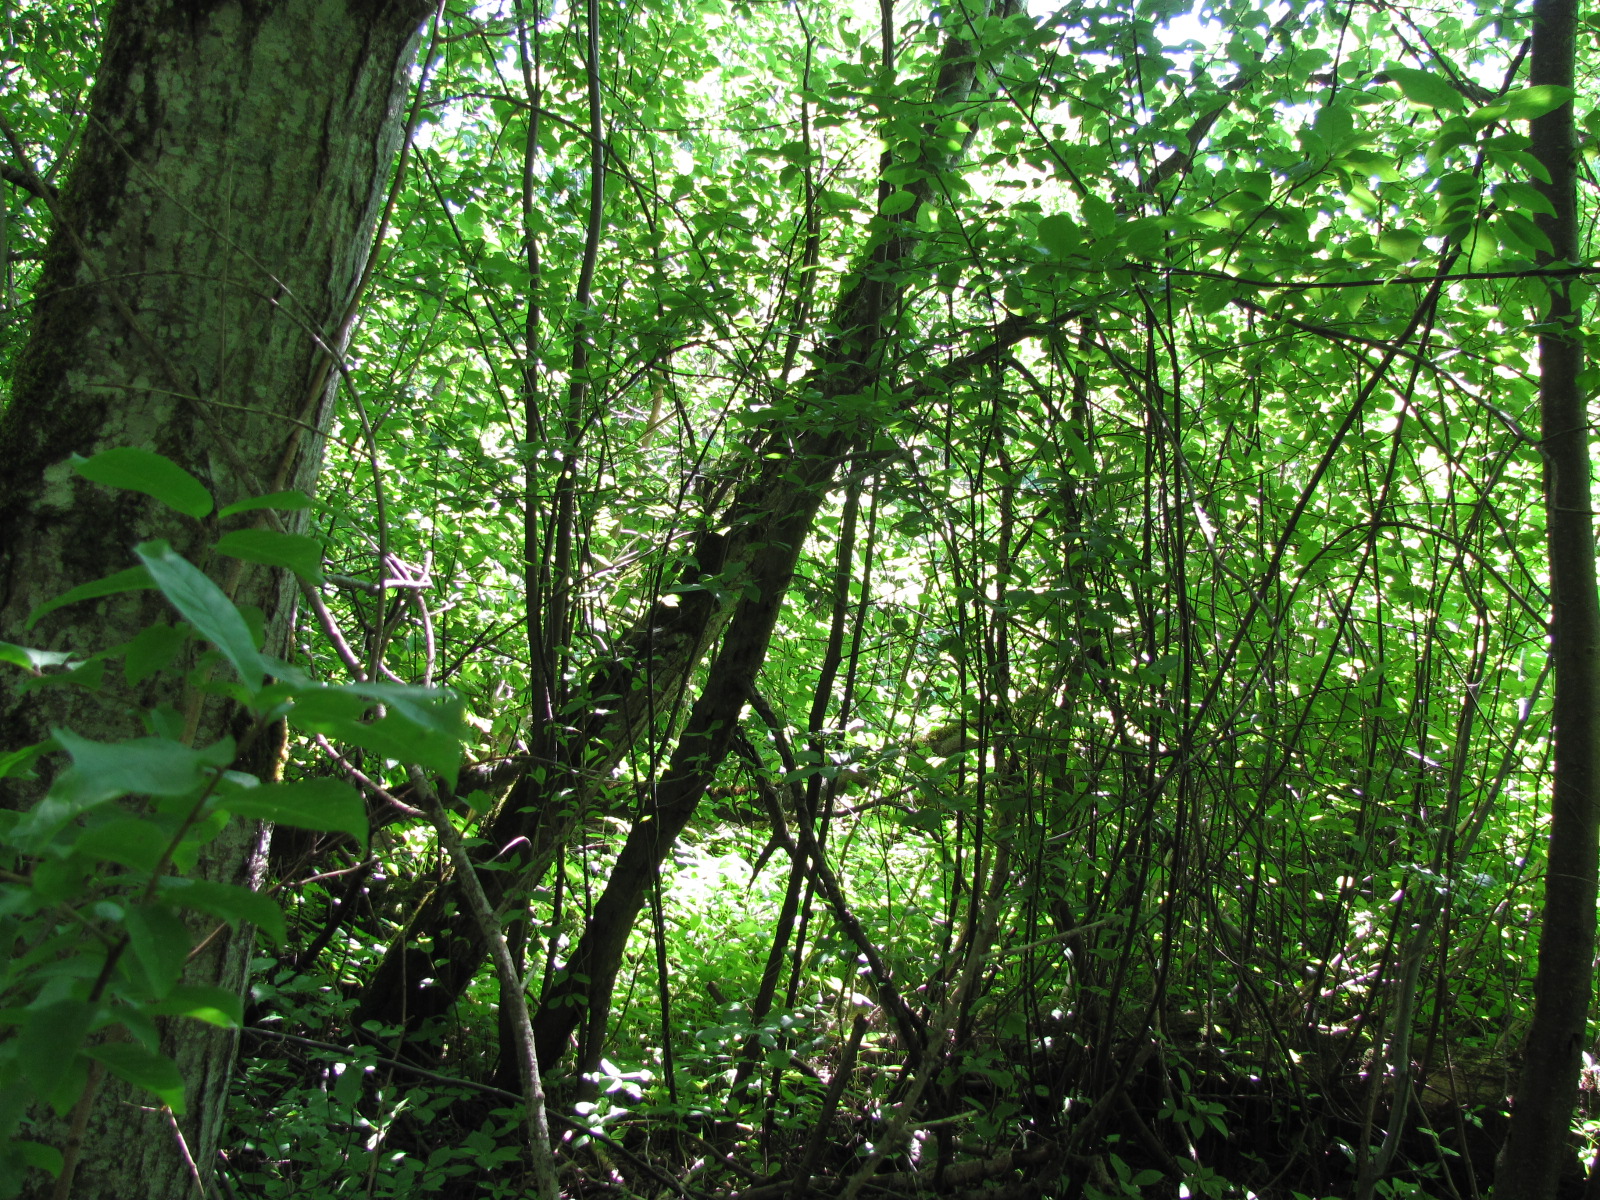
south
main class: Woodland
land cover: Broadleaved woodland
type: floodplain forest
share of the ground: > 75 %
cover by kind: broadleaved forest trees 100 %
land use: Semi-natural and natural areas not in use
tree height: > 5 m
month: June
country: LV
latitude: 56.9669
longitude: 24.5192
